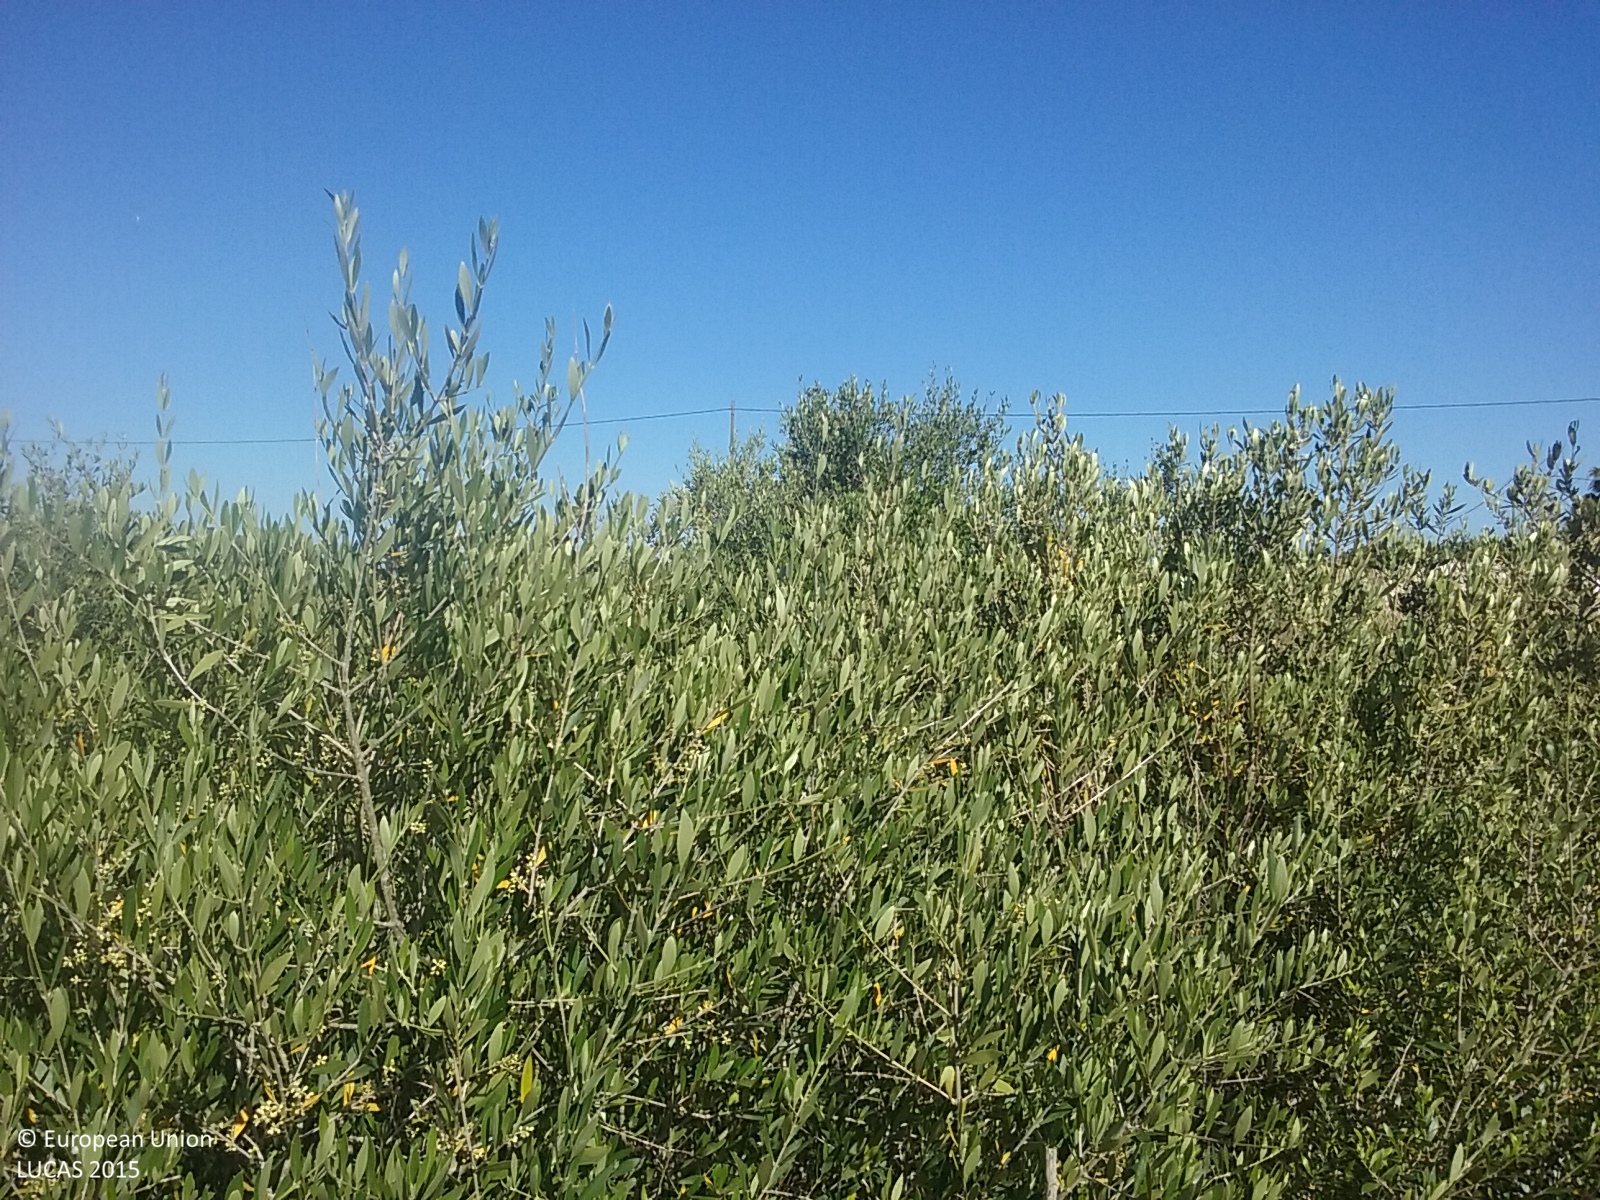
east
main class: Cropland
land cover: Olive groves
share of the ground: 50 - 75 %
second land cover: Grassland without tree/shrub cover
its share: 50 - 75 %
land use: Abandoned areas
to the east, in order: Olive groves; Grassland without tree/shrub cover; Electric lines; Olive groves; Grass margins; Other bare soil; Electric lines; Other bare soil; Grass margins; Abandoned hedges; Dry stone walls; Other bare soil; Dry stone walls; Grass margins; Spontaneously vegetated surfaces; Ditches and canals; Other citrus fruit
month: May
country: ES
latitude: 40.2183
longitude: 0.2567
